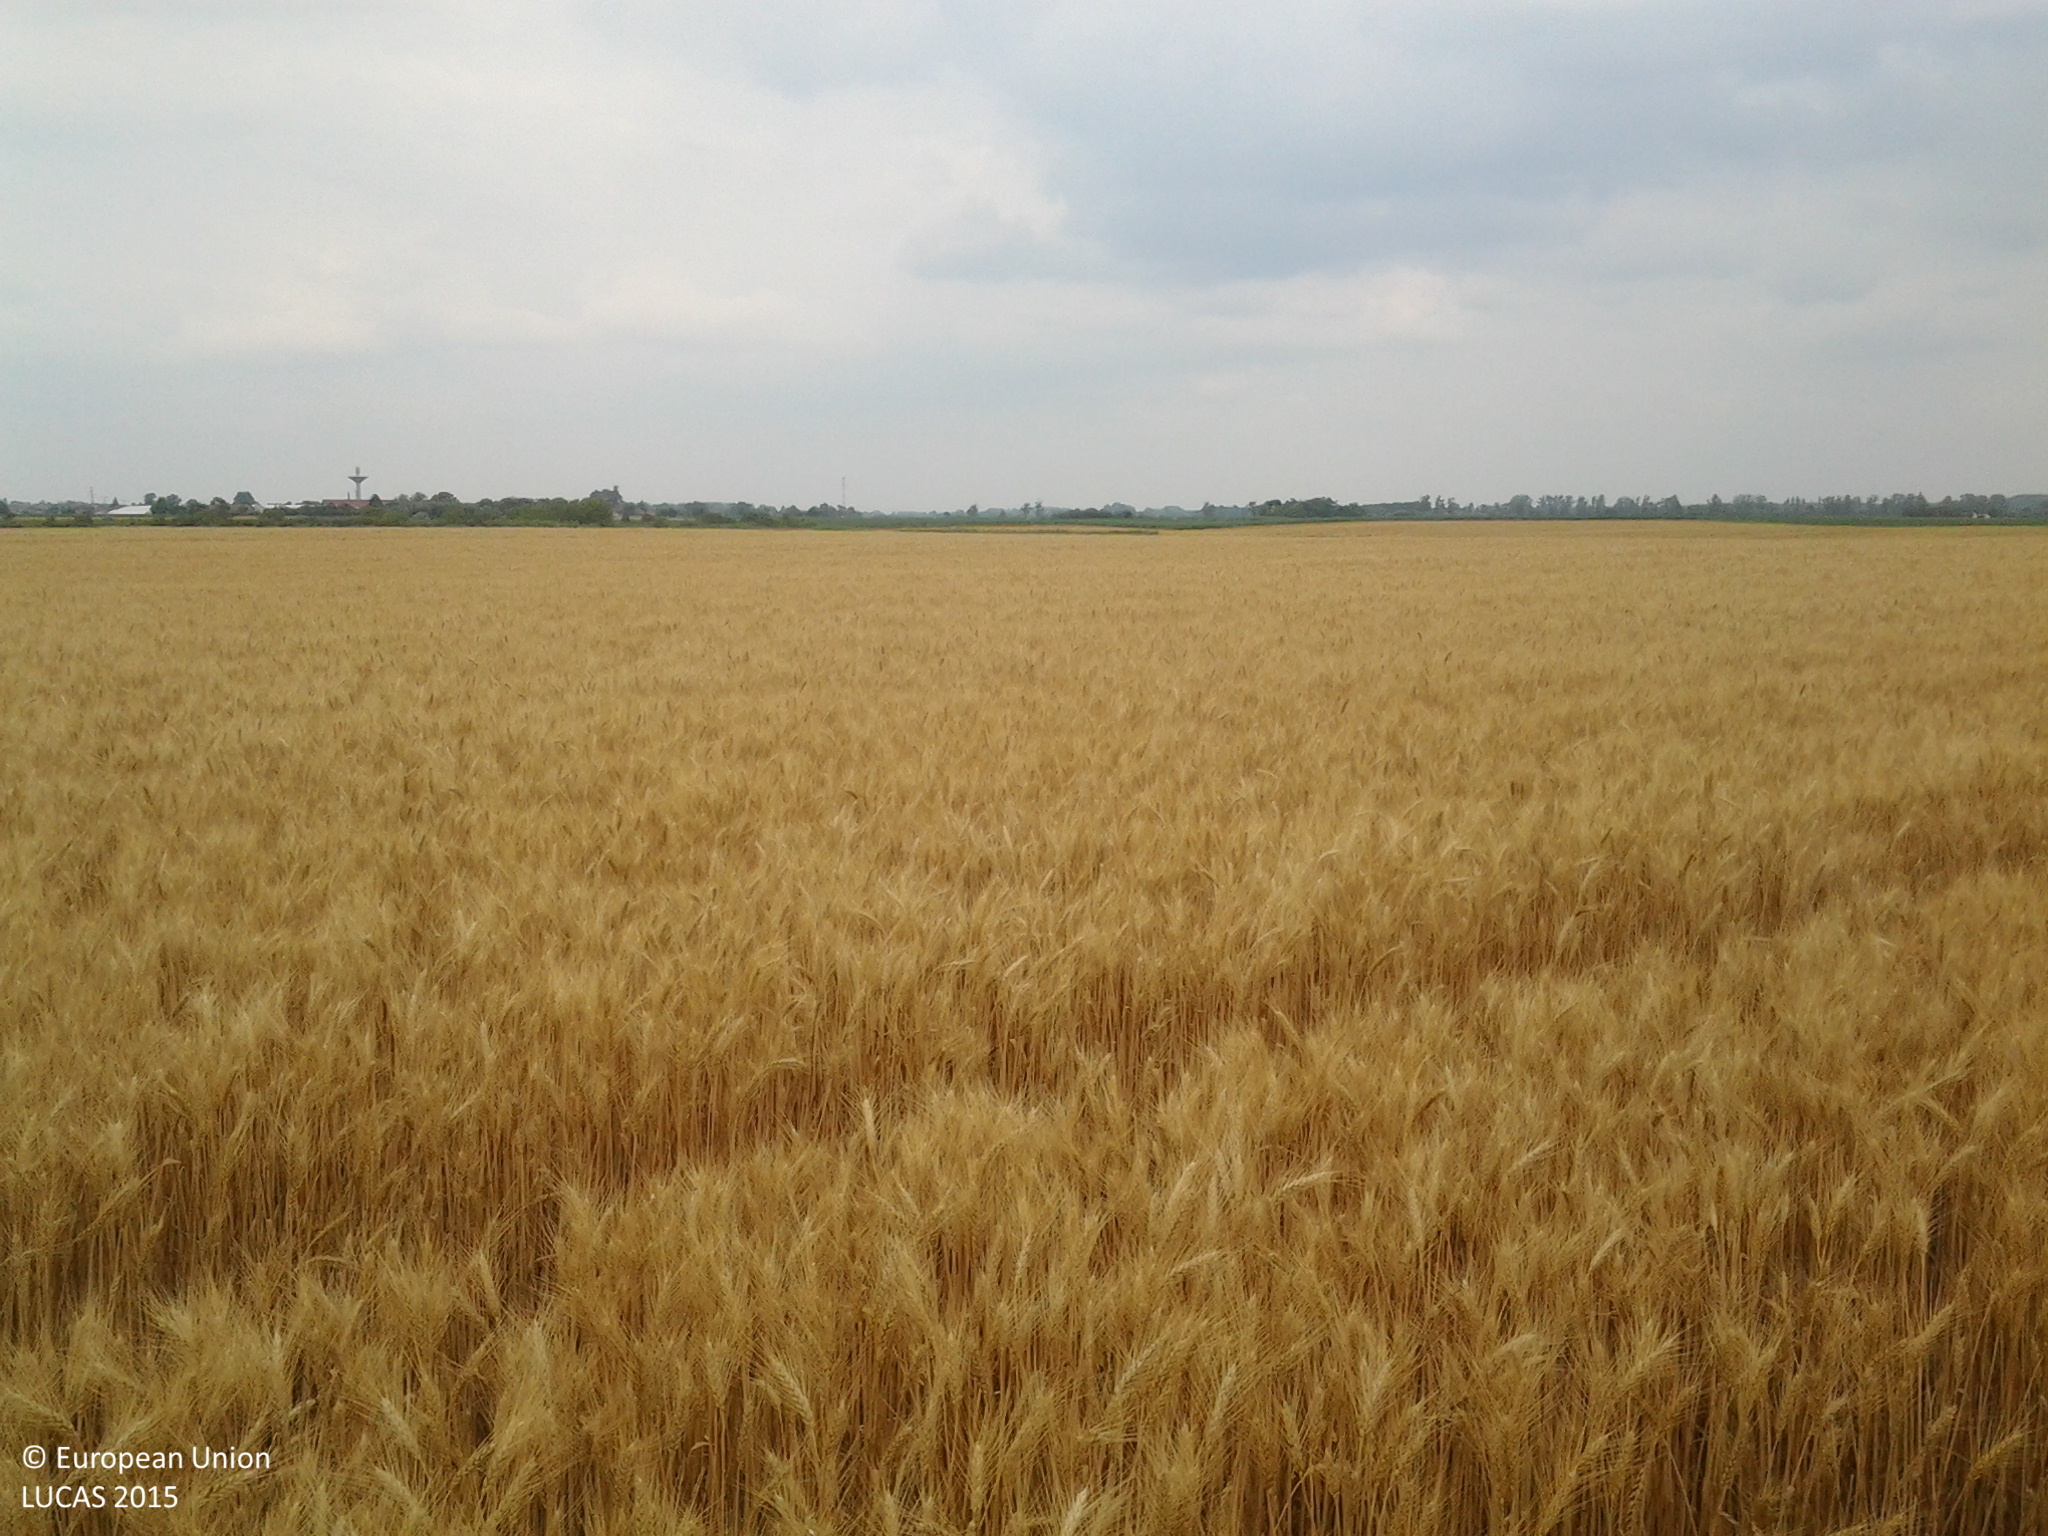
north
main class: Cropland
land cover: Common wheat
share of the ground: > 75 %
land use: Agriculture (excluding fallow land and kitchen gardens)
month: June
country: HU
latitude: 46.8568
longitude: 19.2375
